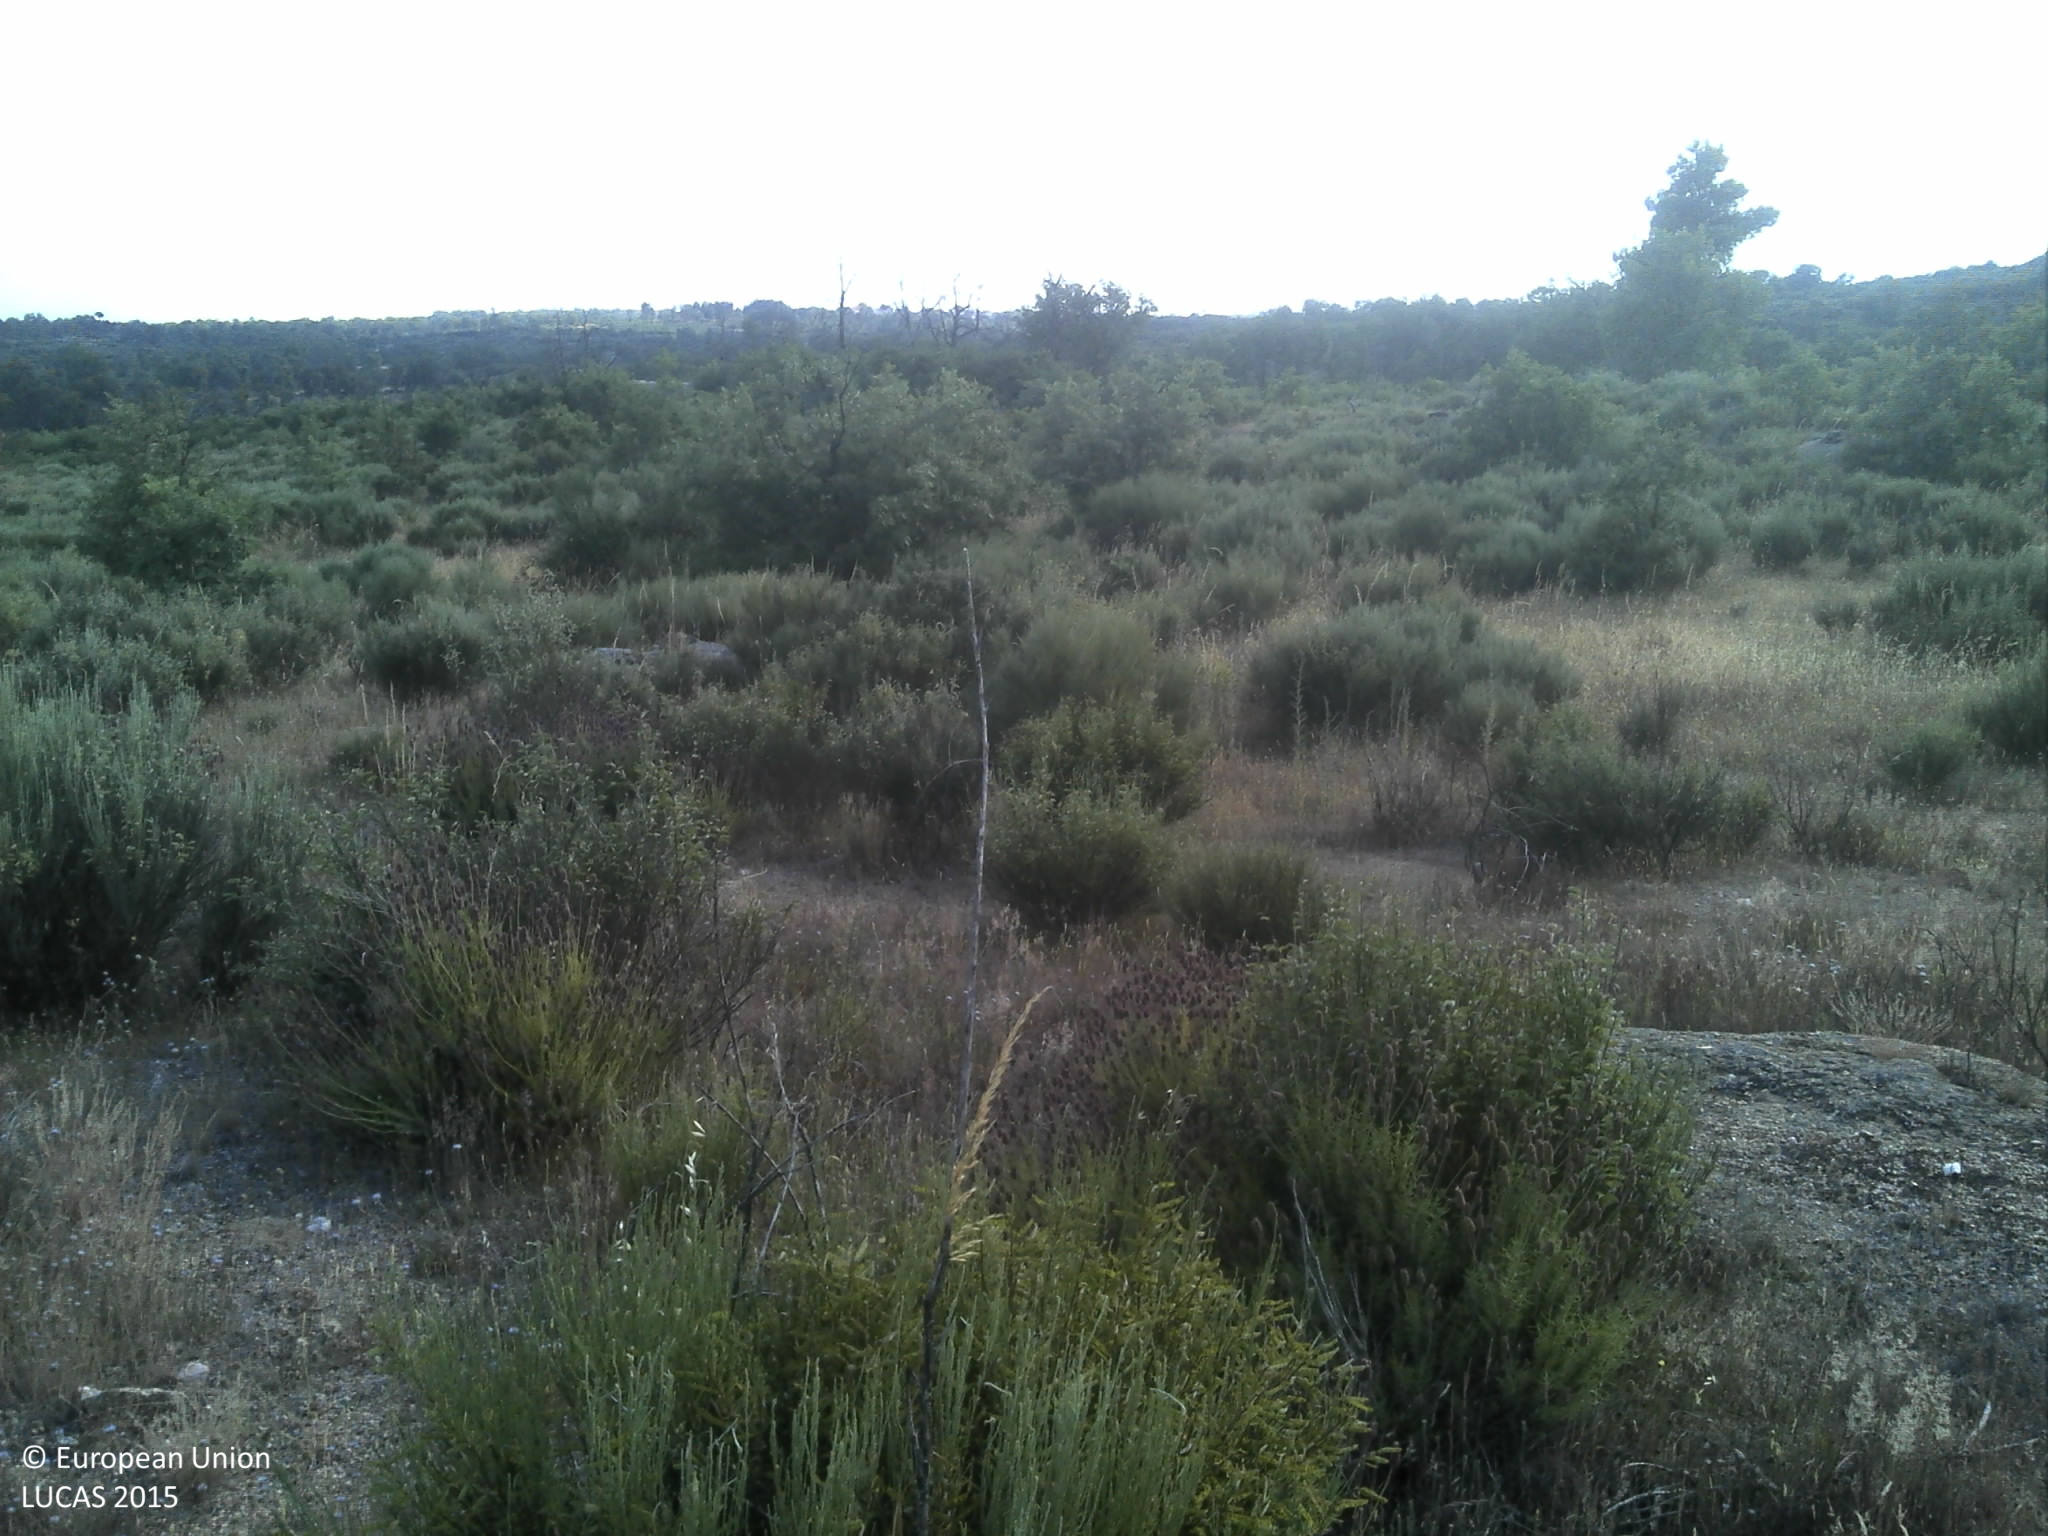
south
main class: Shrubland
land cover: Shrubland without tree cover
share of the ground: 50 - 75 %
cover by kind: shrubs 65 %, unconsolidated bare surface 15 %, herbaceous plants 10 %, consolidated bare surface 10 %
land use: Semi-natural and natural areas not in use
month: June
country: PT
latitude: 40.4948
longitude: -7.0550
